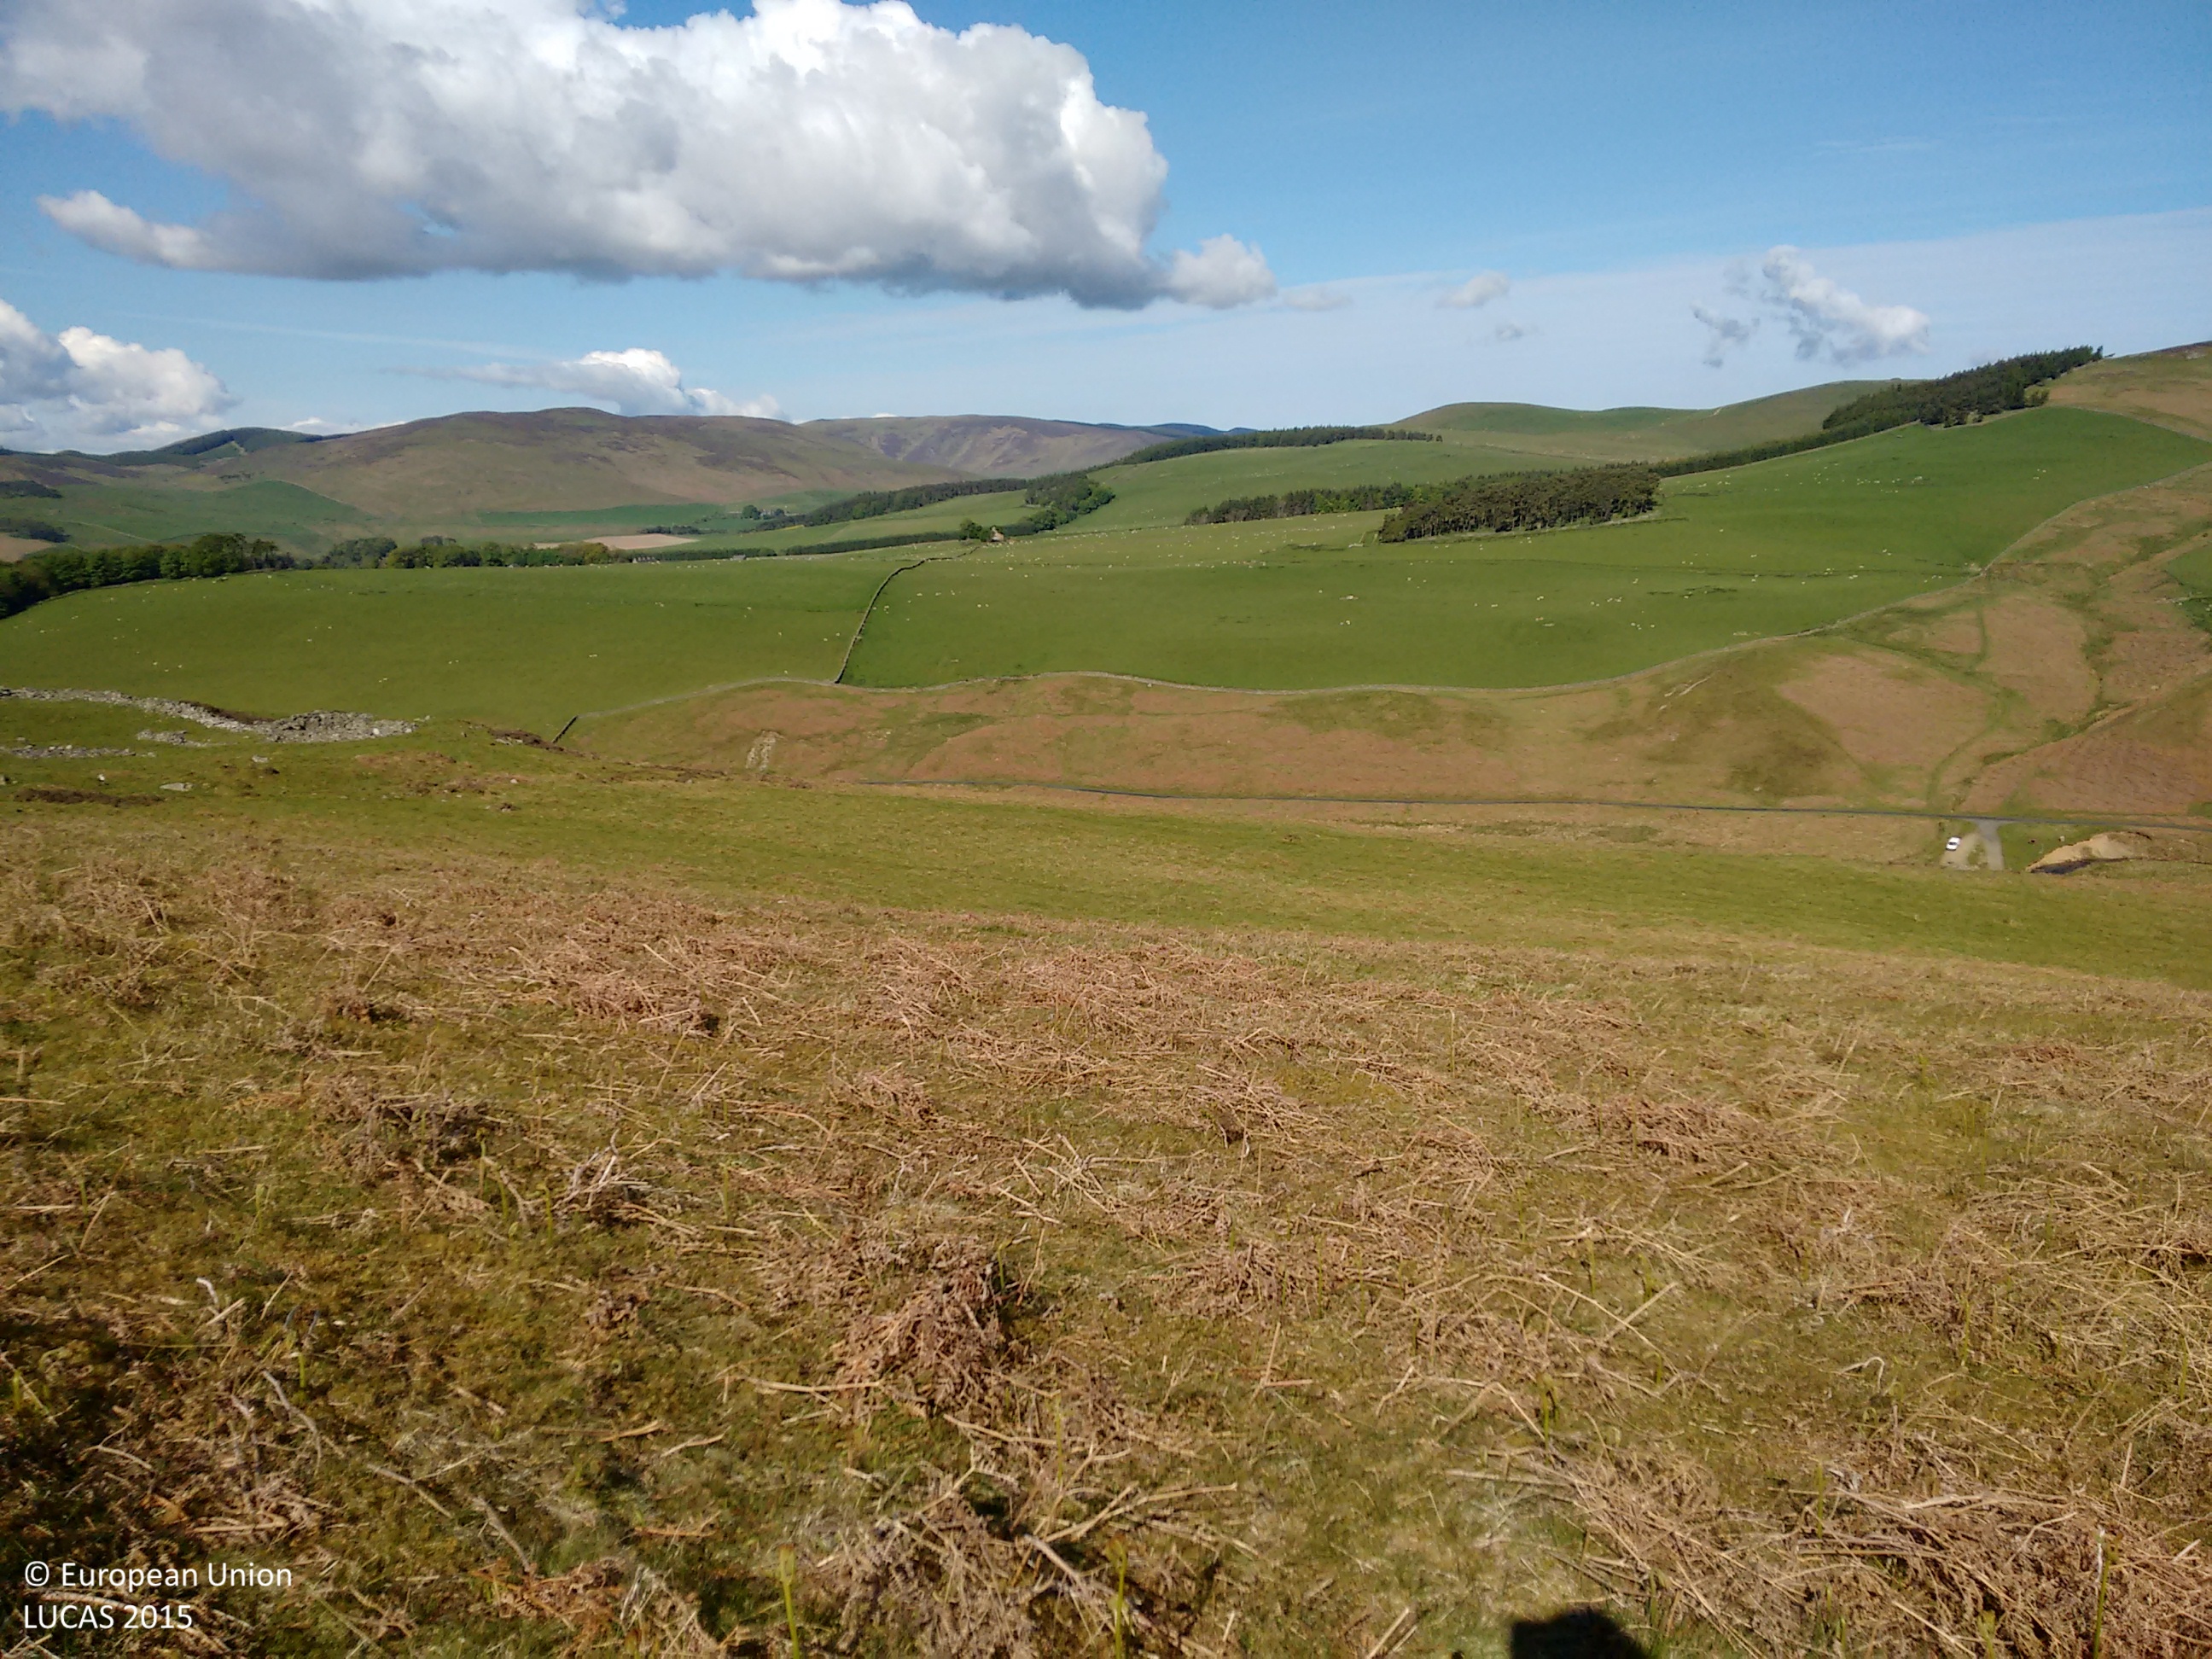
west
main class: Grassland
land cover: Grassland without tree/shrub cover
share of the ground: > 75 %
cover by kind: herbaceous plants 90 %, lichens and mosses 10 %
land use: Agriculture (excluding fallow land and kitchen gardens)
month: June
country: GB
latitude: 55.6607
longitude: -3.2511
